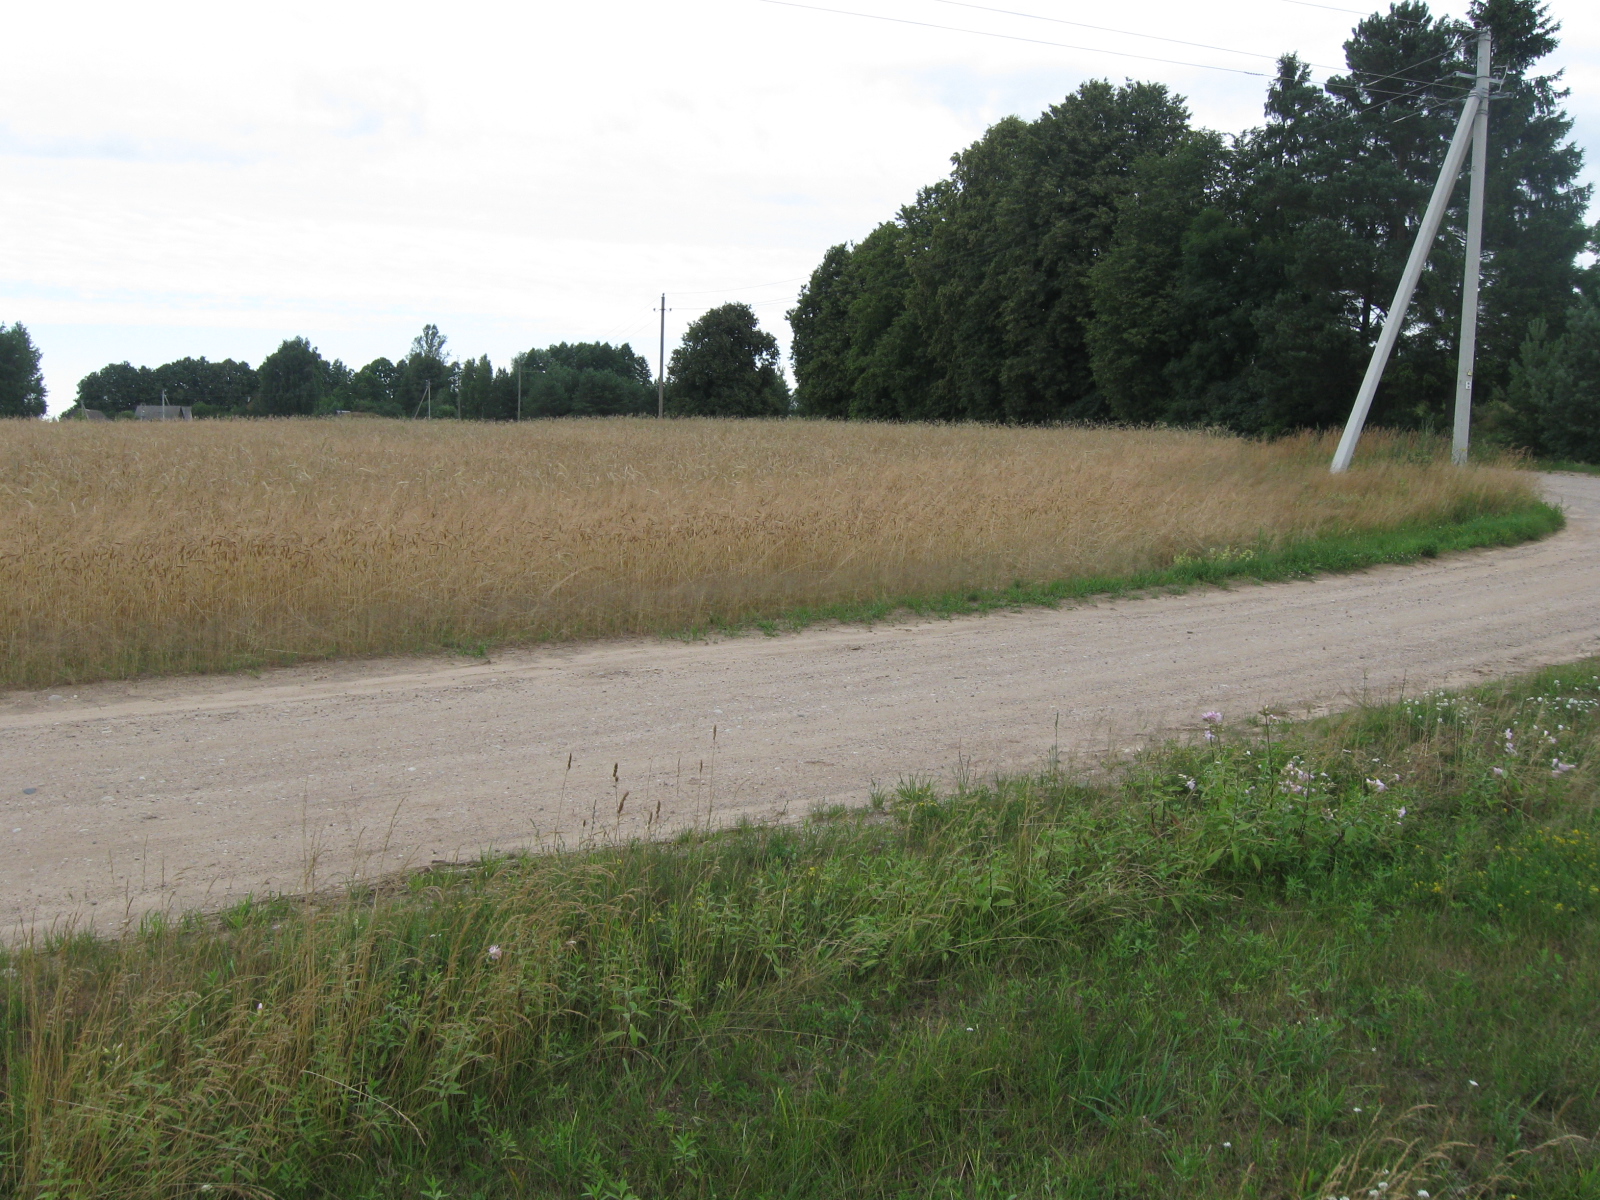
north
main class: Grassland
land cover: Grassland without tree/shrub cover
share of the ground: > 75 %
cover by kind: herbaceous plants 90 %, unconsolidated bare surface 10 %
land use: Agriculture (excluding fallow land and kitchen gardens)
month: July
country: LT
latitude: 55.0128
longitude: 23.6734
